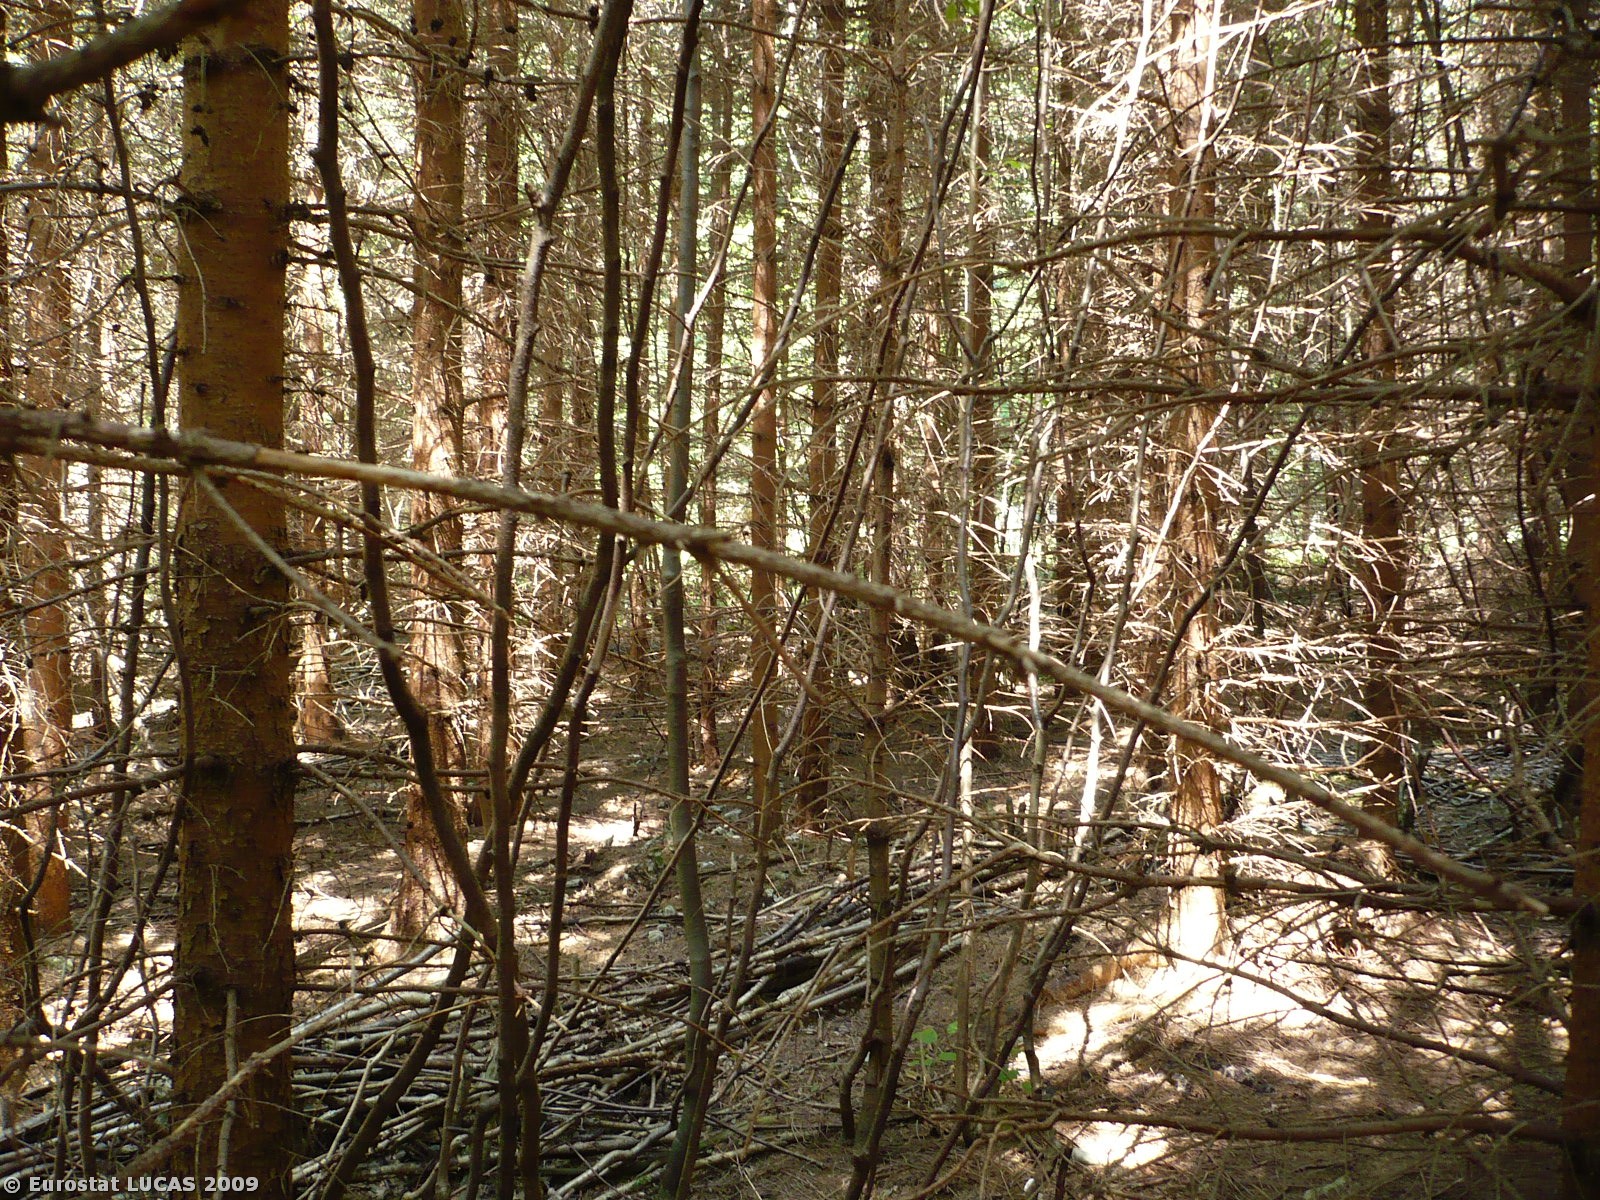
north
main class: Woodland
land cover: Coniferous woodland
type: hemiboreal forest and nemoral coniferous forest and mixed broadleaved-coniferous forest
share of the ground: > 75 %
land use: Forestry
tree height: > 5 m
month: July
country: SI
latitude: 45.6866
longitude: 14.3228
